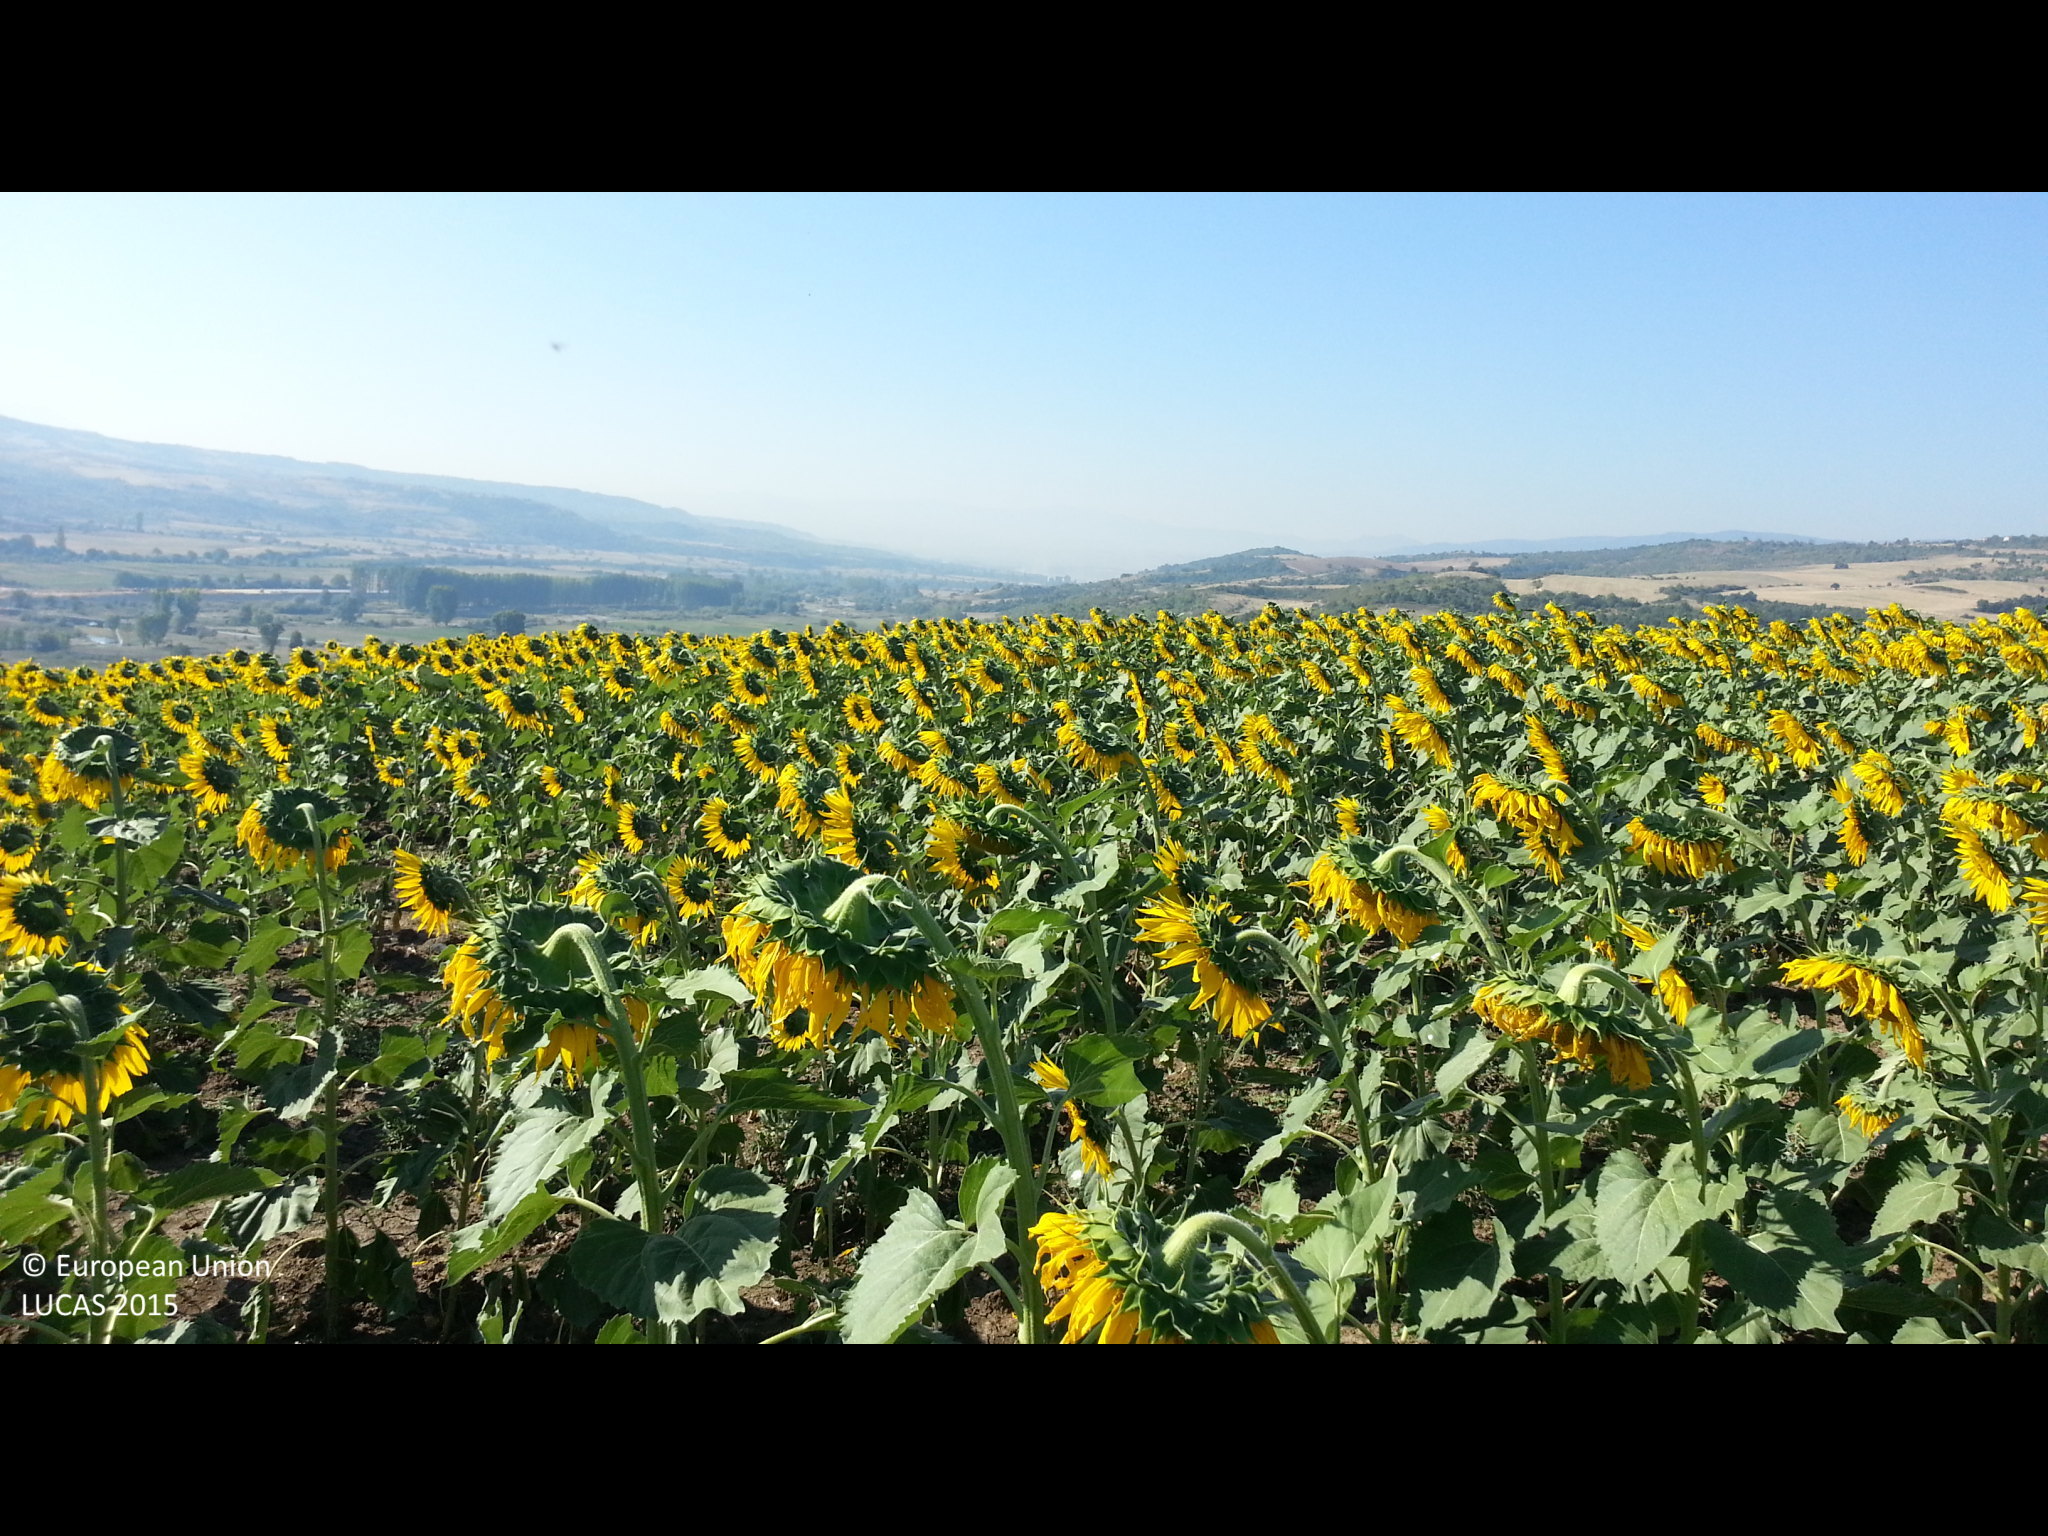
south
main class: Cropland
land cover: Sunflower
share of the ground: > 75 %
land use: Agriculture (excluding fallow land and kitchen gardens)
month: September
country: BG
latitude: 42.2082
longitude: 23.0463
